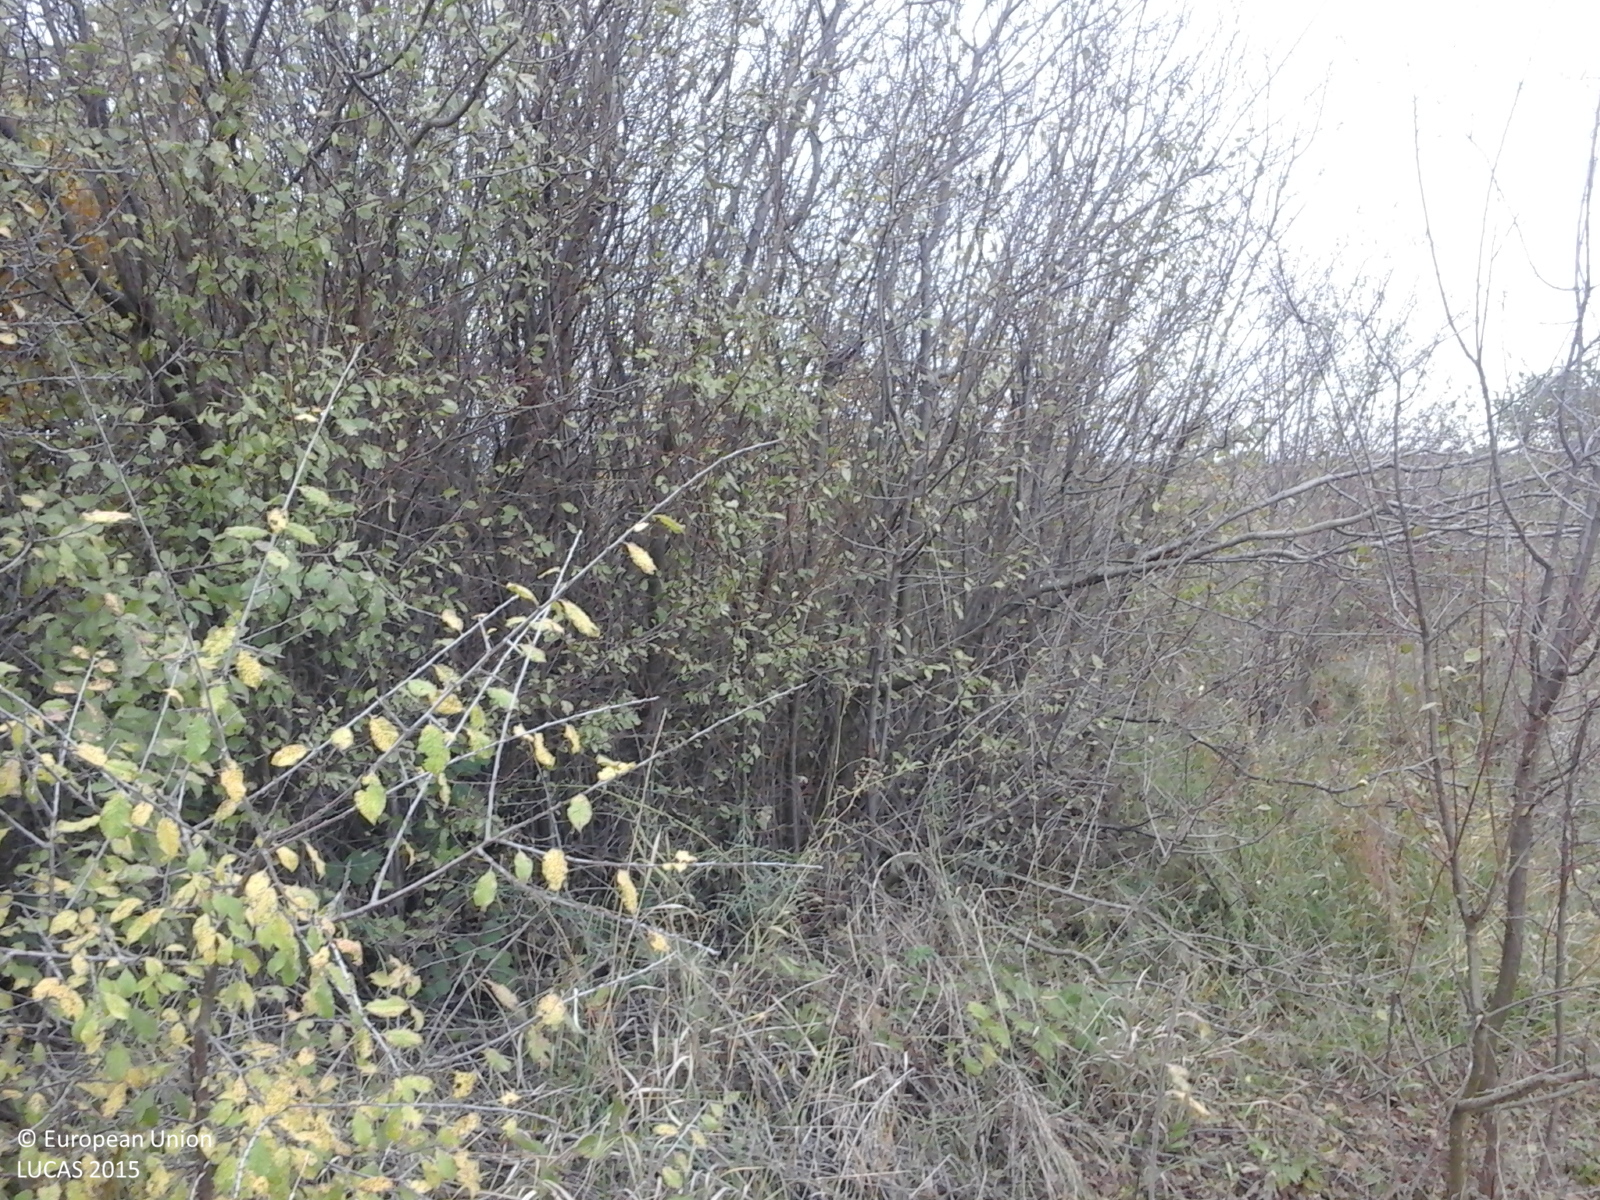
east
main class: Cropland
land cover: Common wheat
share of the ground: < 10 %
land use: Agriculture (excluding fallow land and kitchen gardens)
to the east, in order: Ditches and canals; Grass margins; Common wheat; Spontaneously vegetated surfaces; Common wheat; Grass margins; Rivers and streams; Paved roads, cycling and walking lanes
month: October
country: RO
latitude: 44.7600
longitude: 26.0632
